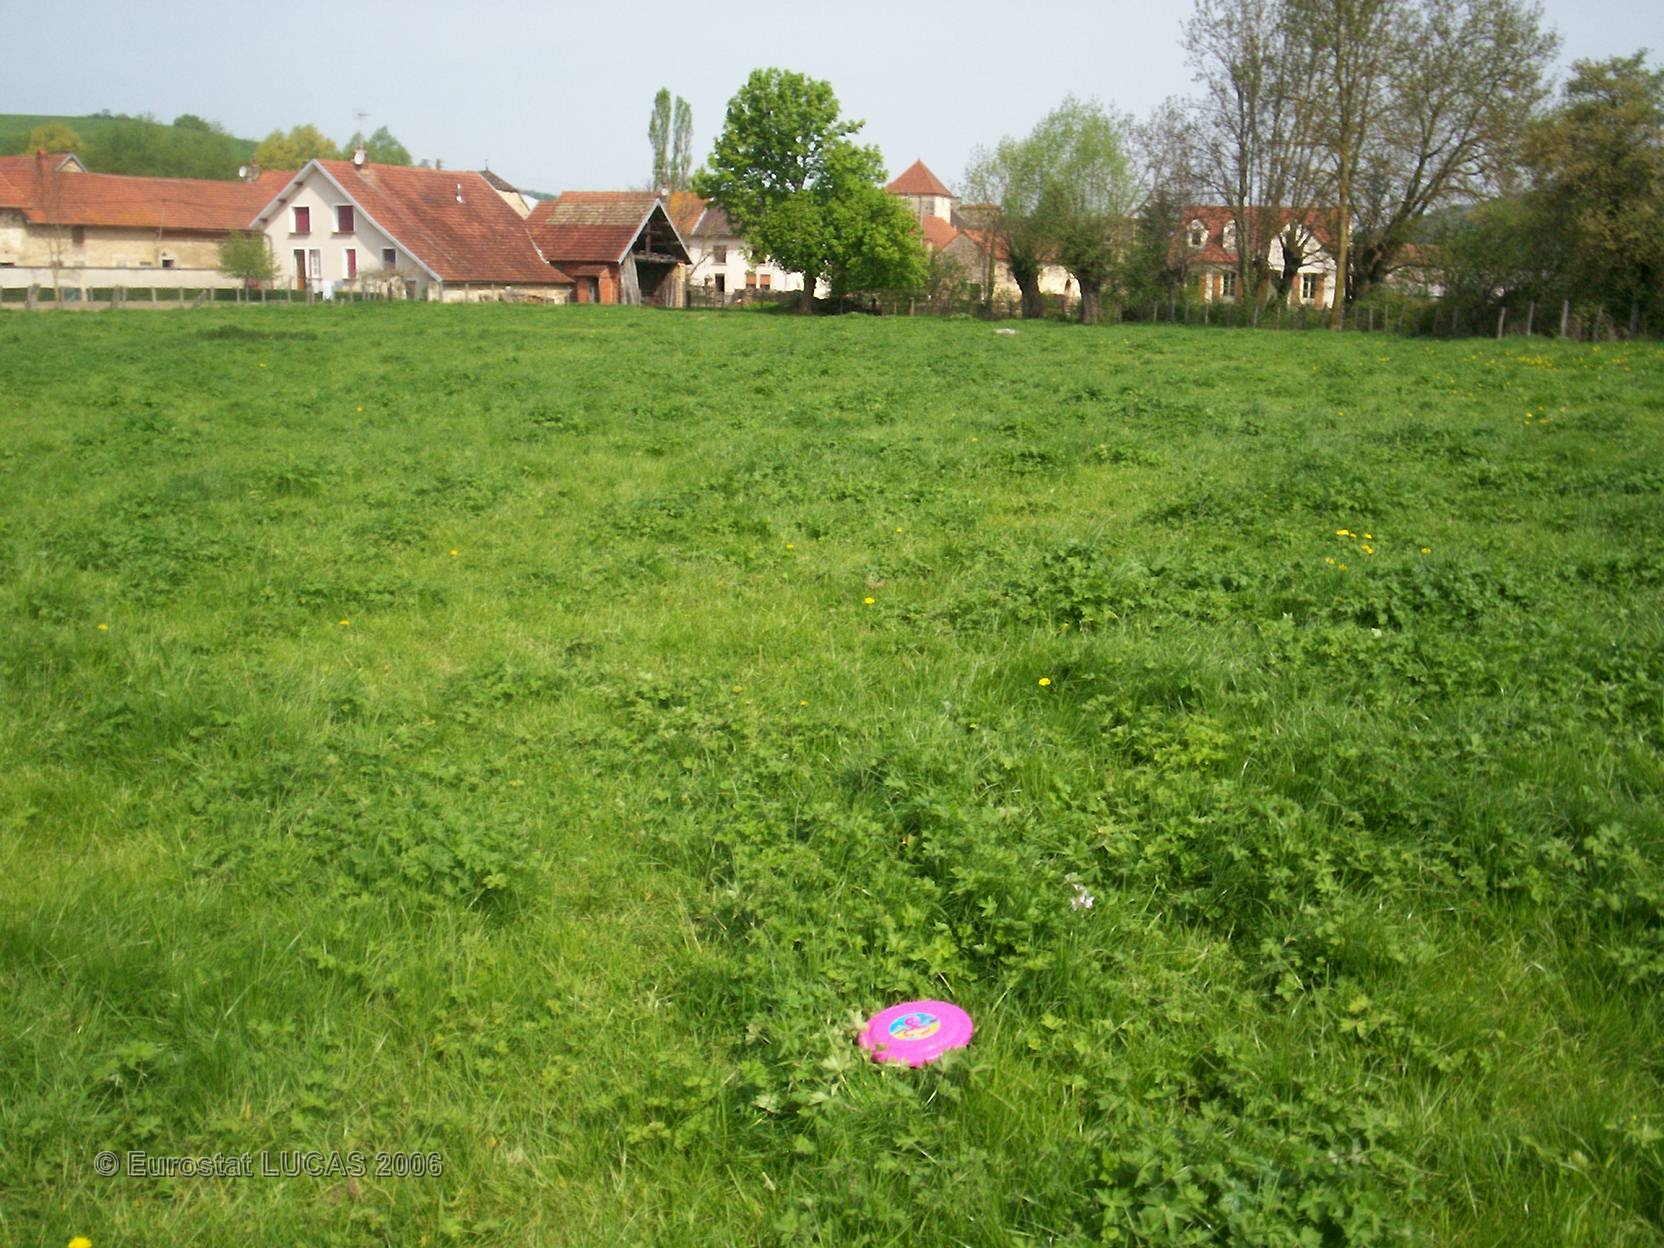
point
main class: Grassland
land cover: Grassland without tree/shrub cover
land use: Agriculture (excluding fallow land and kitchen gardens)
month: May
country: FR
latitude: 47.4420
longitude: 4.6023
